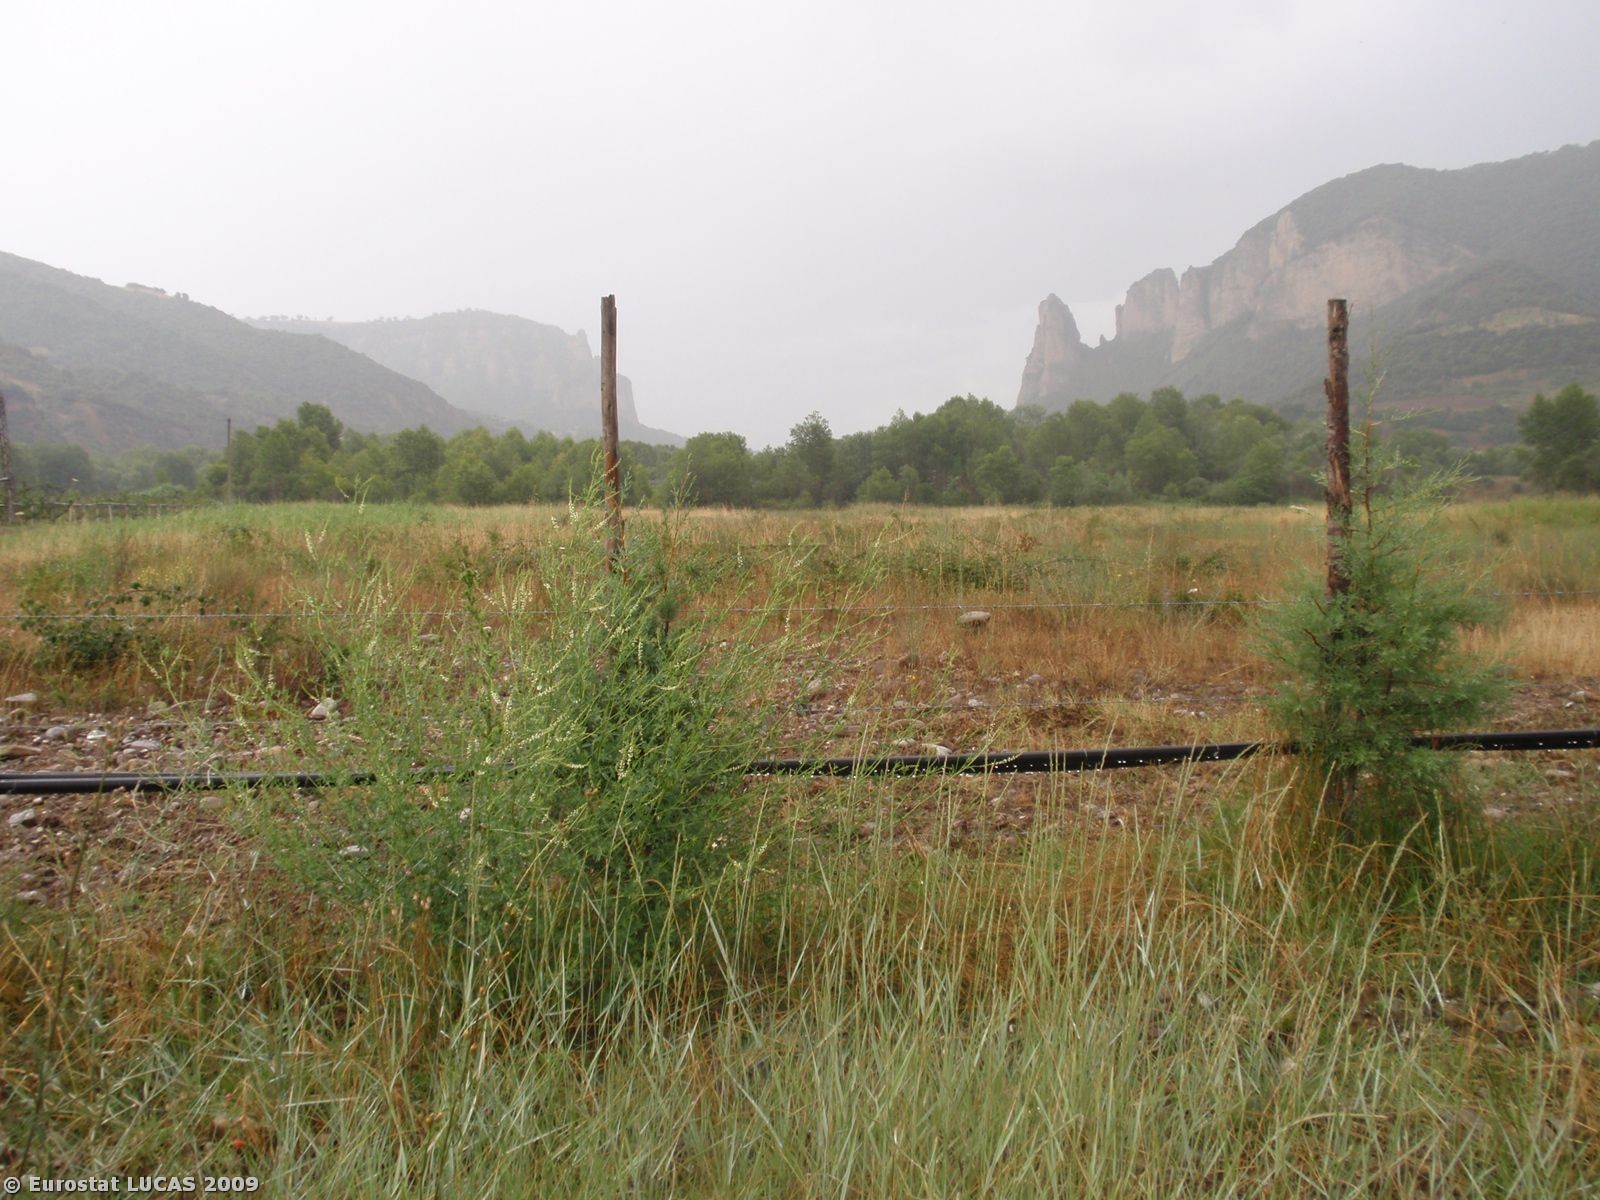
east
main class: Grassland
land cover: Spontaneously vegetated surfaces
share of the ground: > 75 %
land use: Fallow land
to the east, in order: Spontaneously vegetated surfaces; Broadleaved woodland; Rivers and streams; Broadleaved woodland
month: June
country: IT
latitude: 40.2588
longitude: 16.1010
